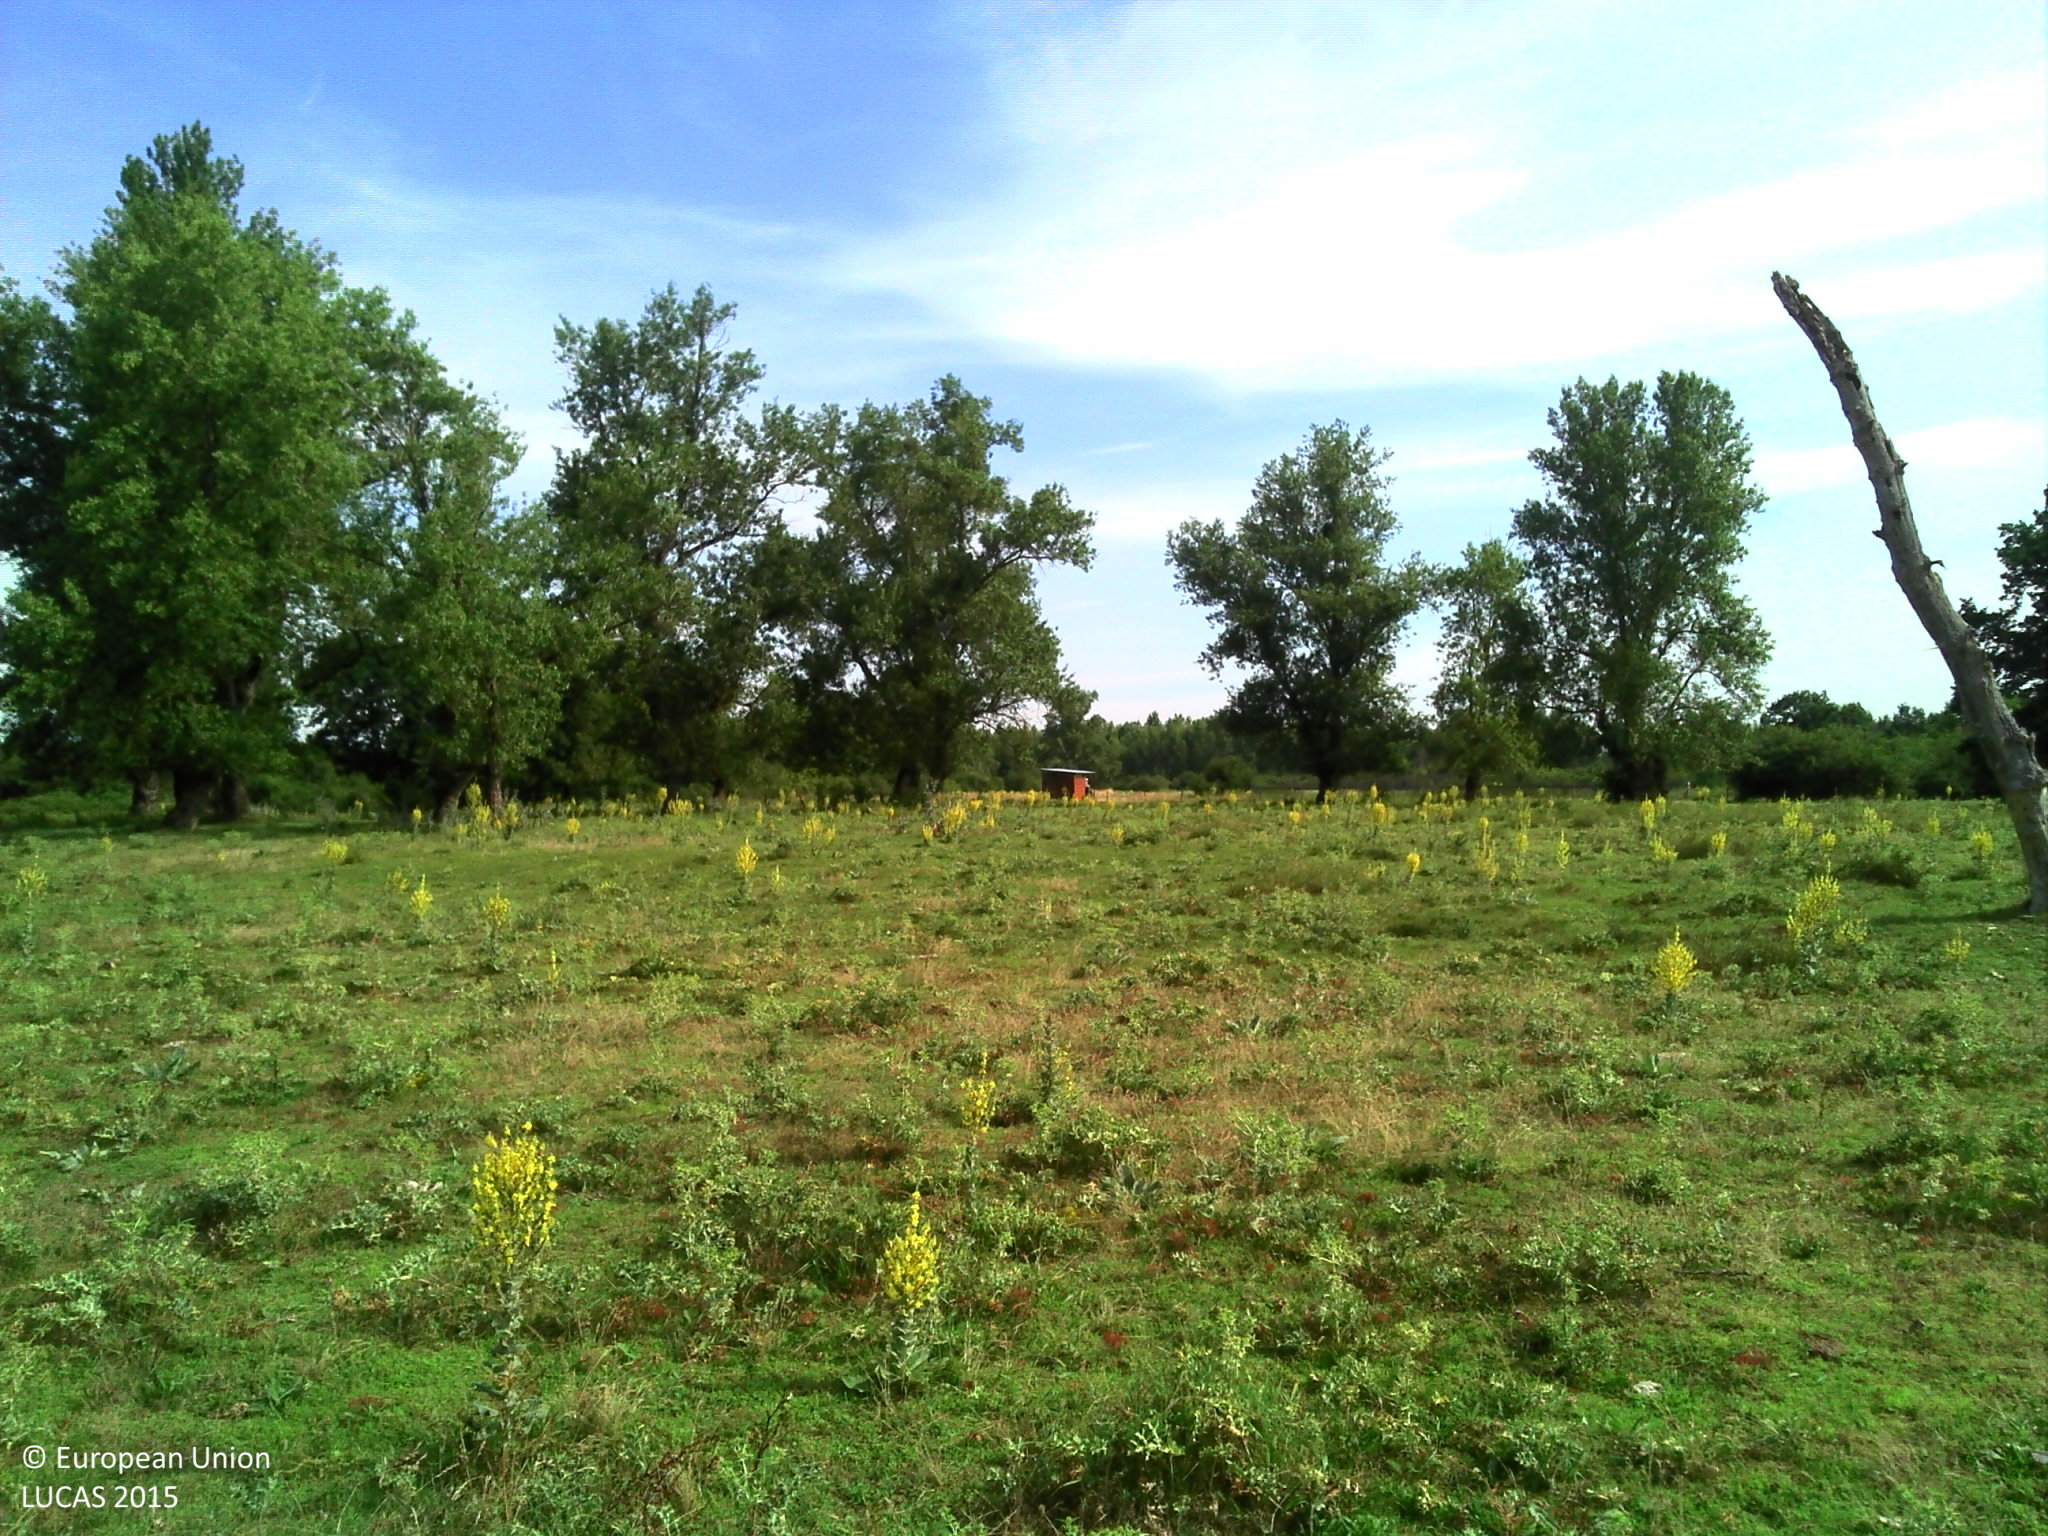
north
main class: Grassland
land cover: Grassland without tree/shrub cover
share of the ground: > 75 %
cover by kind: herbaceous plants 95 %, shrubs 5 %
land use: Agriculture (excluding fallow land and kitchen gardens)
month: June
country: FR
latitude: 46.3599
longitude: 3.3313
